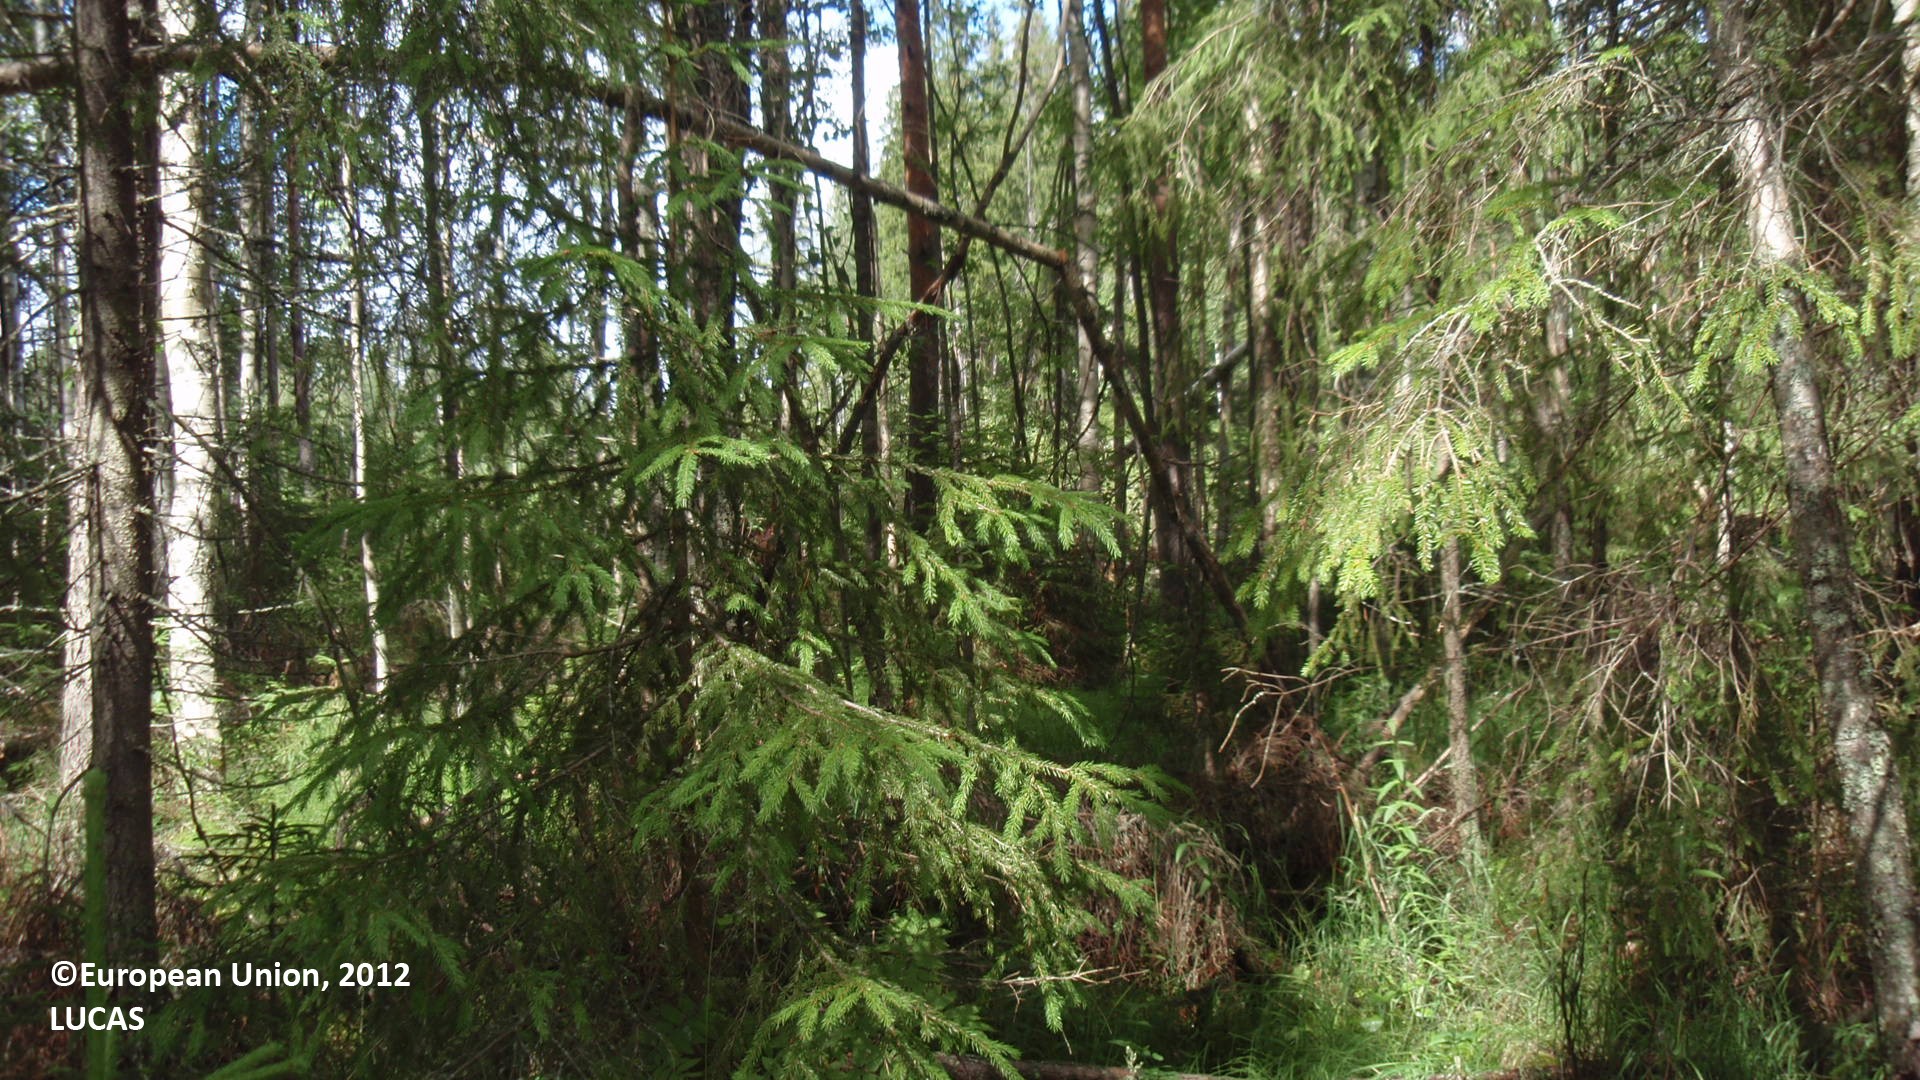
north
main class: Woodland
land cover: Spruce dominated mixed woodland
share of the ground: 50 - 75 %
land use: Forestry
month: July
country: FI
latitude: 61.6371
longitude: 27.4402
